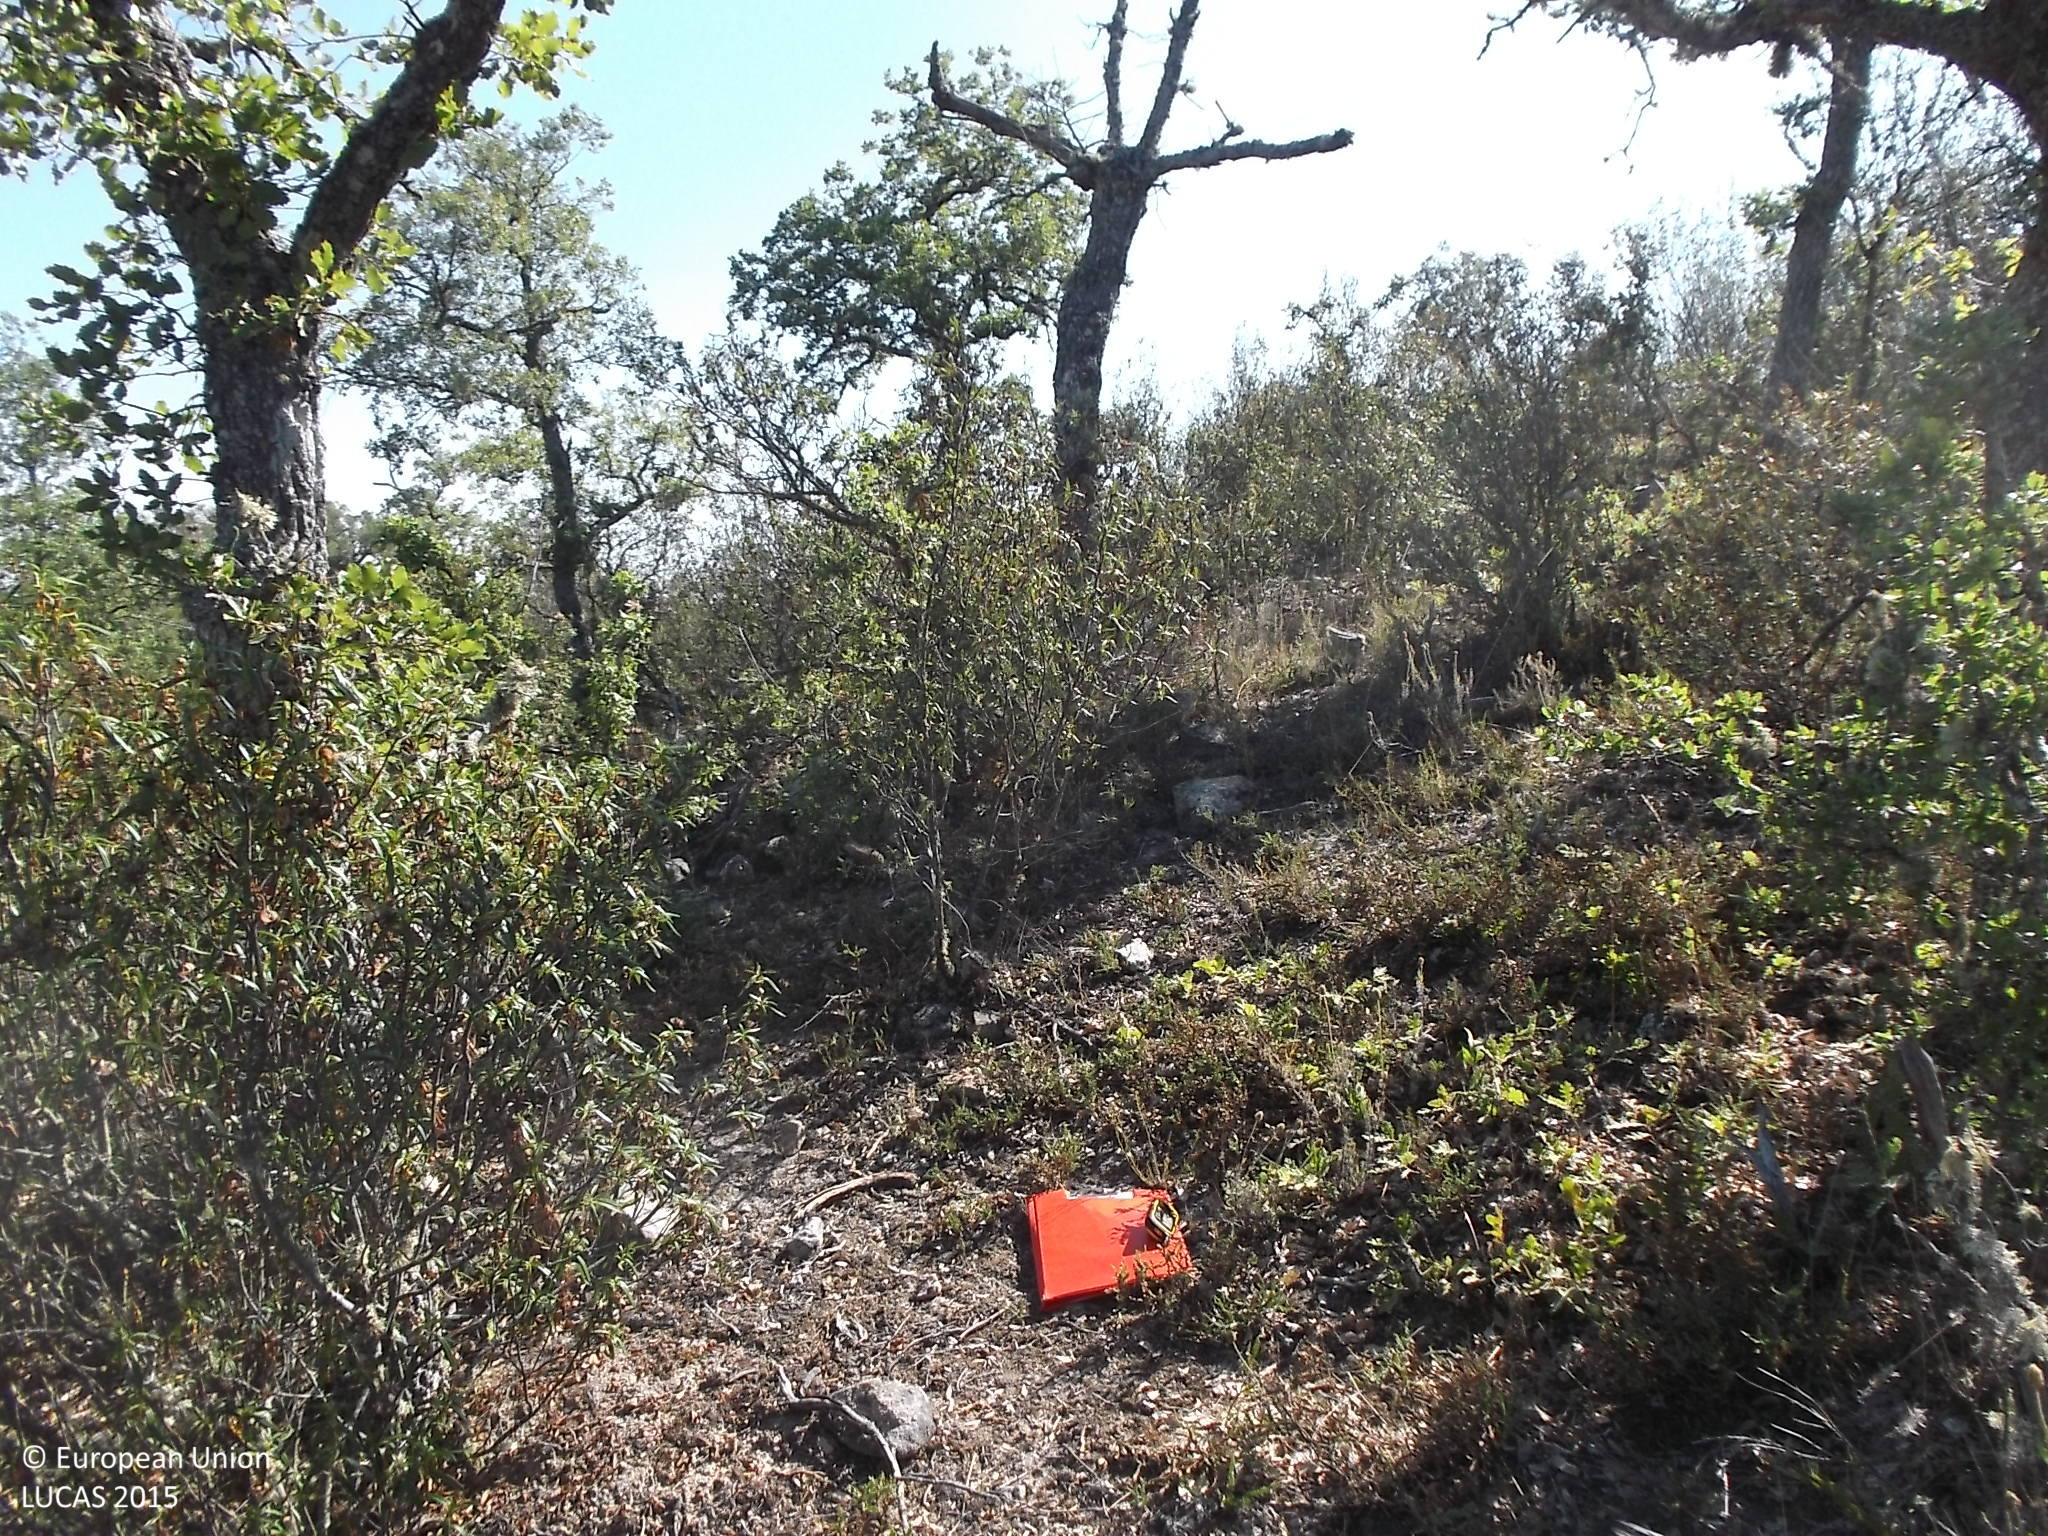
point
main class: Woodland
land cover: Broadleaved woodland
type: broadleaved evergreen forest
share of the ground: 10 - 25 %
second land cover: Shrubland without tree cover
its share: 50 - 75 %
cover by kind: shrubs 80 %, broadleaved forest trees 20 %
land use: Forestry
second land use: Agriculture (excluding fallow land and kitchen gardens)
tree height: < 5 m
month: July
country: ES
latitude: 41.2889
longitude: -5.8352
